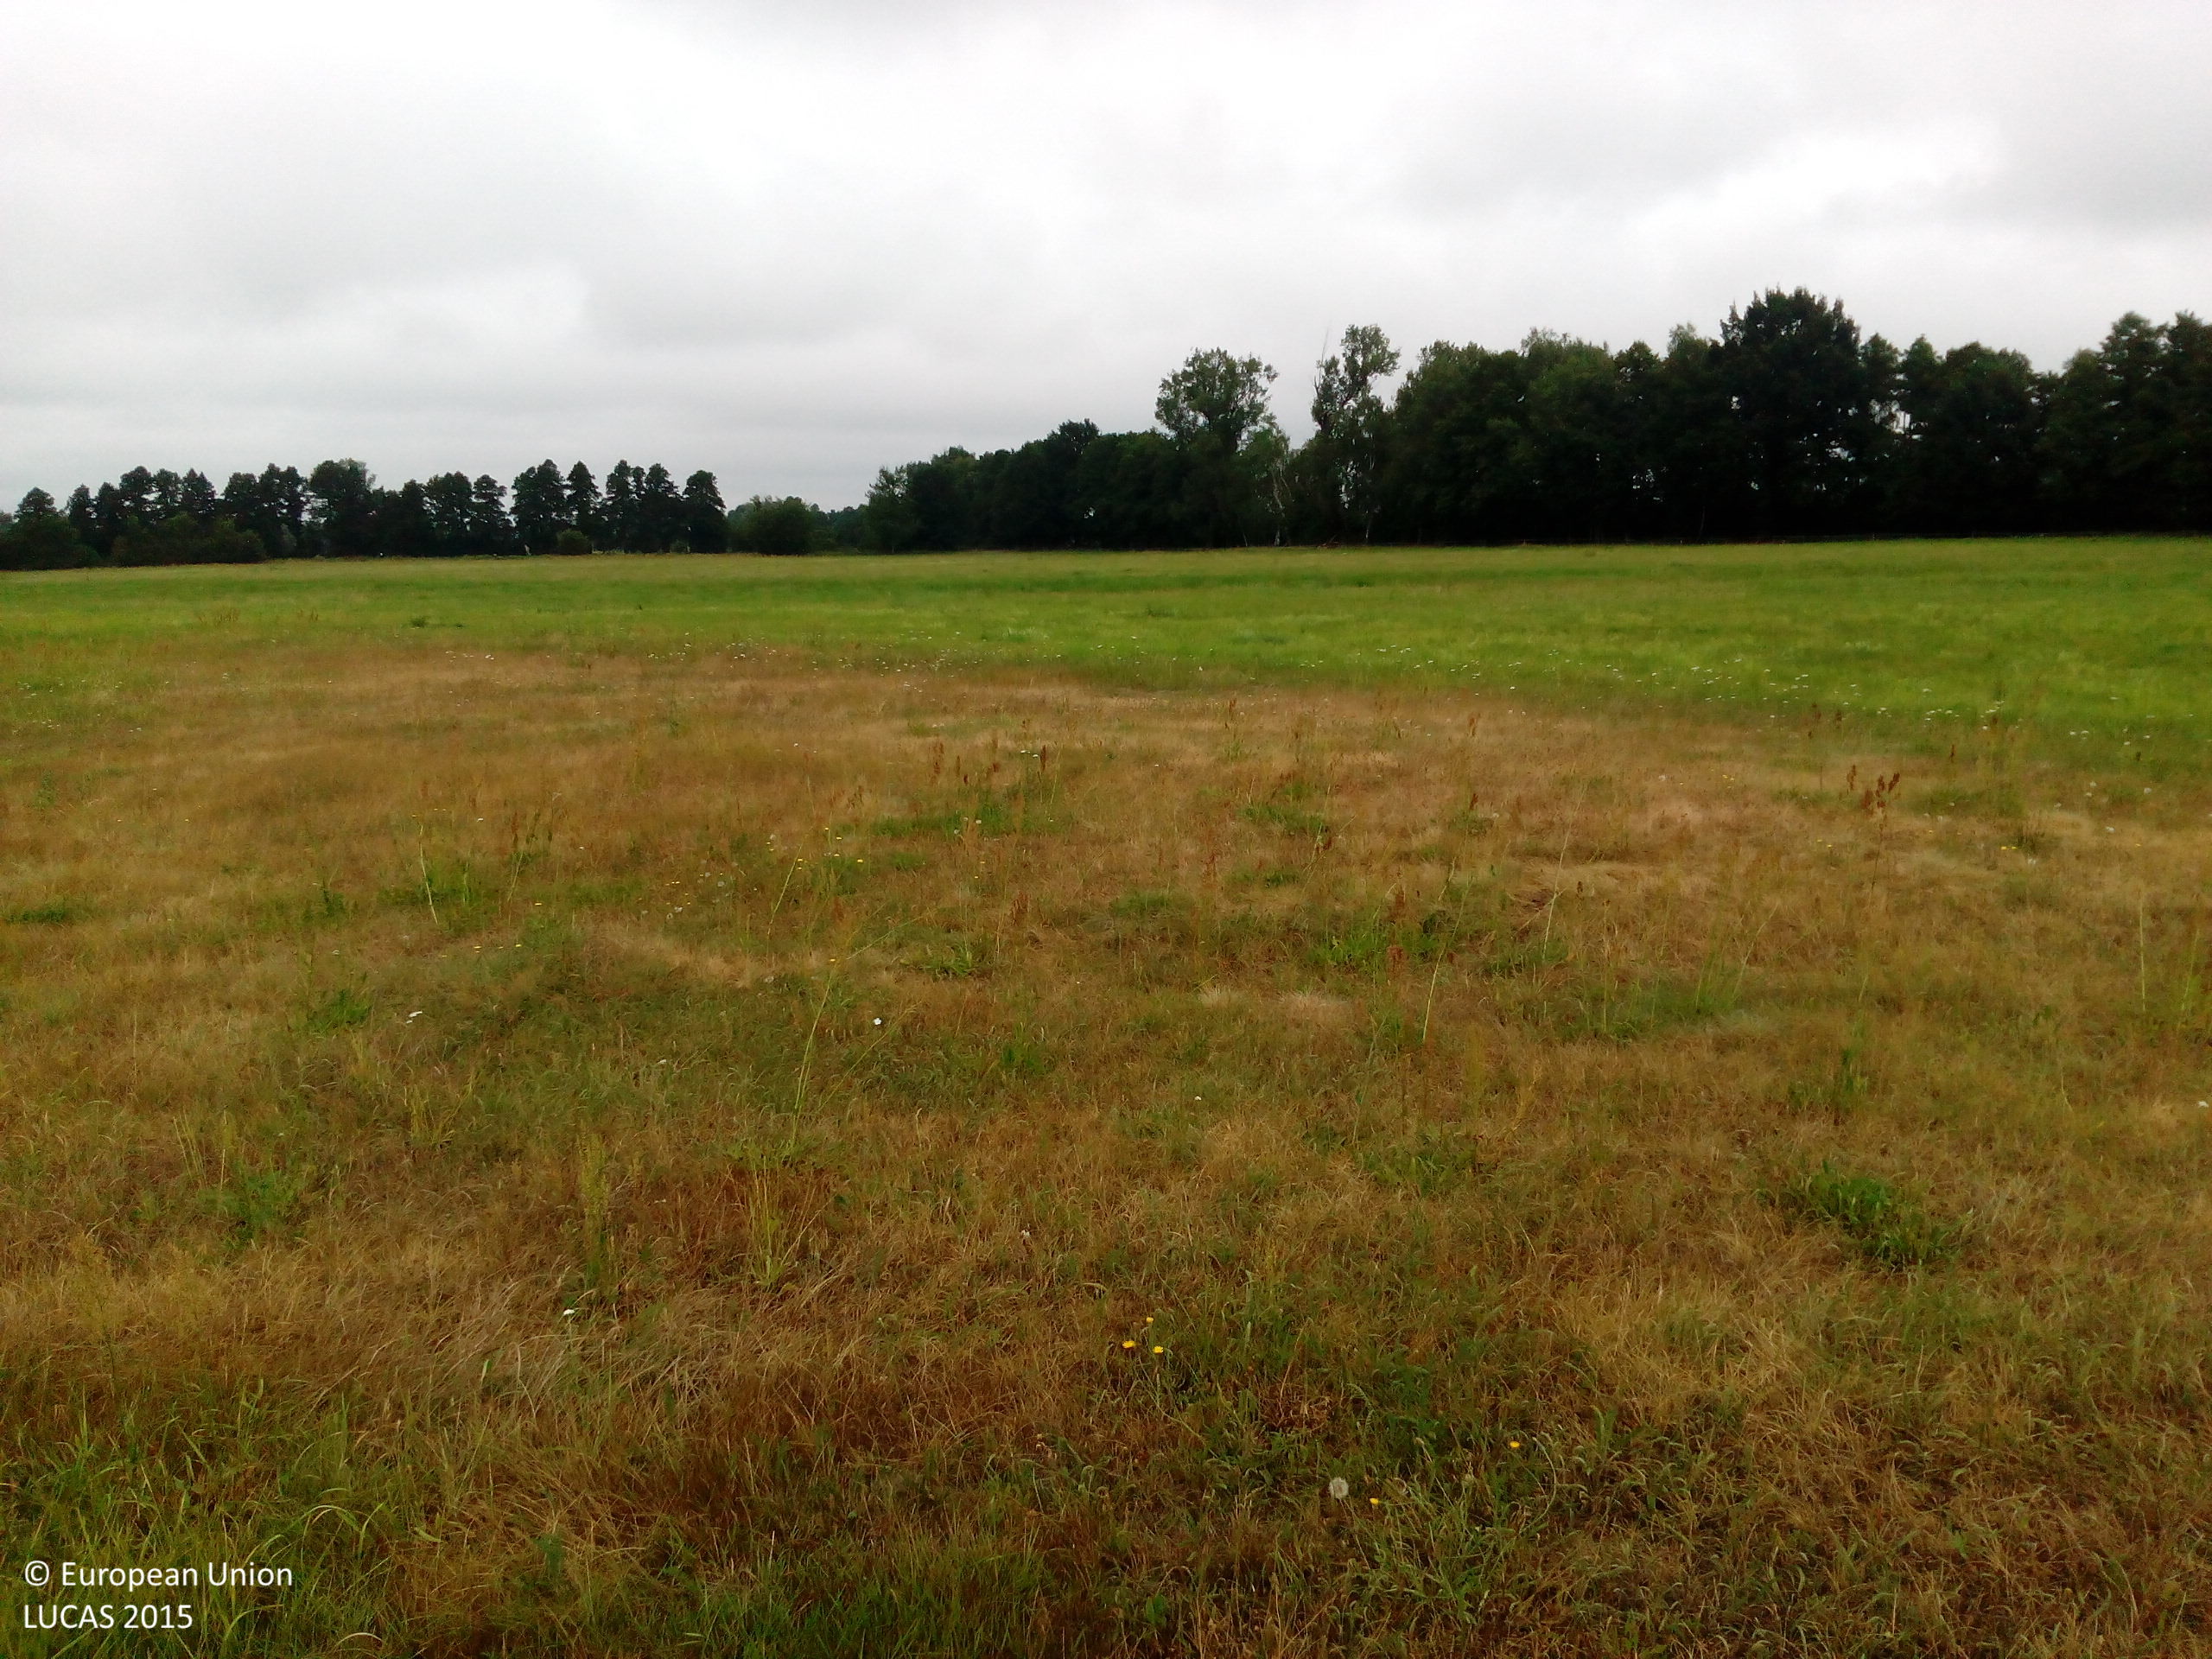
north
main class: Grassland
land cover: Grassland without tree/shrub cover
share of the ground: > 75 %
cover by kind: herbaceous plants 100 %
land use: Agriculture (excluding fallow land and kitchen gardens)
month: August
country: DE
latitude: 51.9112
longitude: 14.0860
